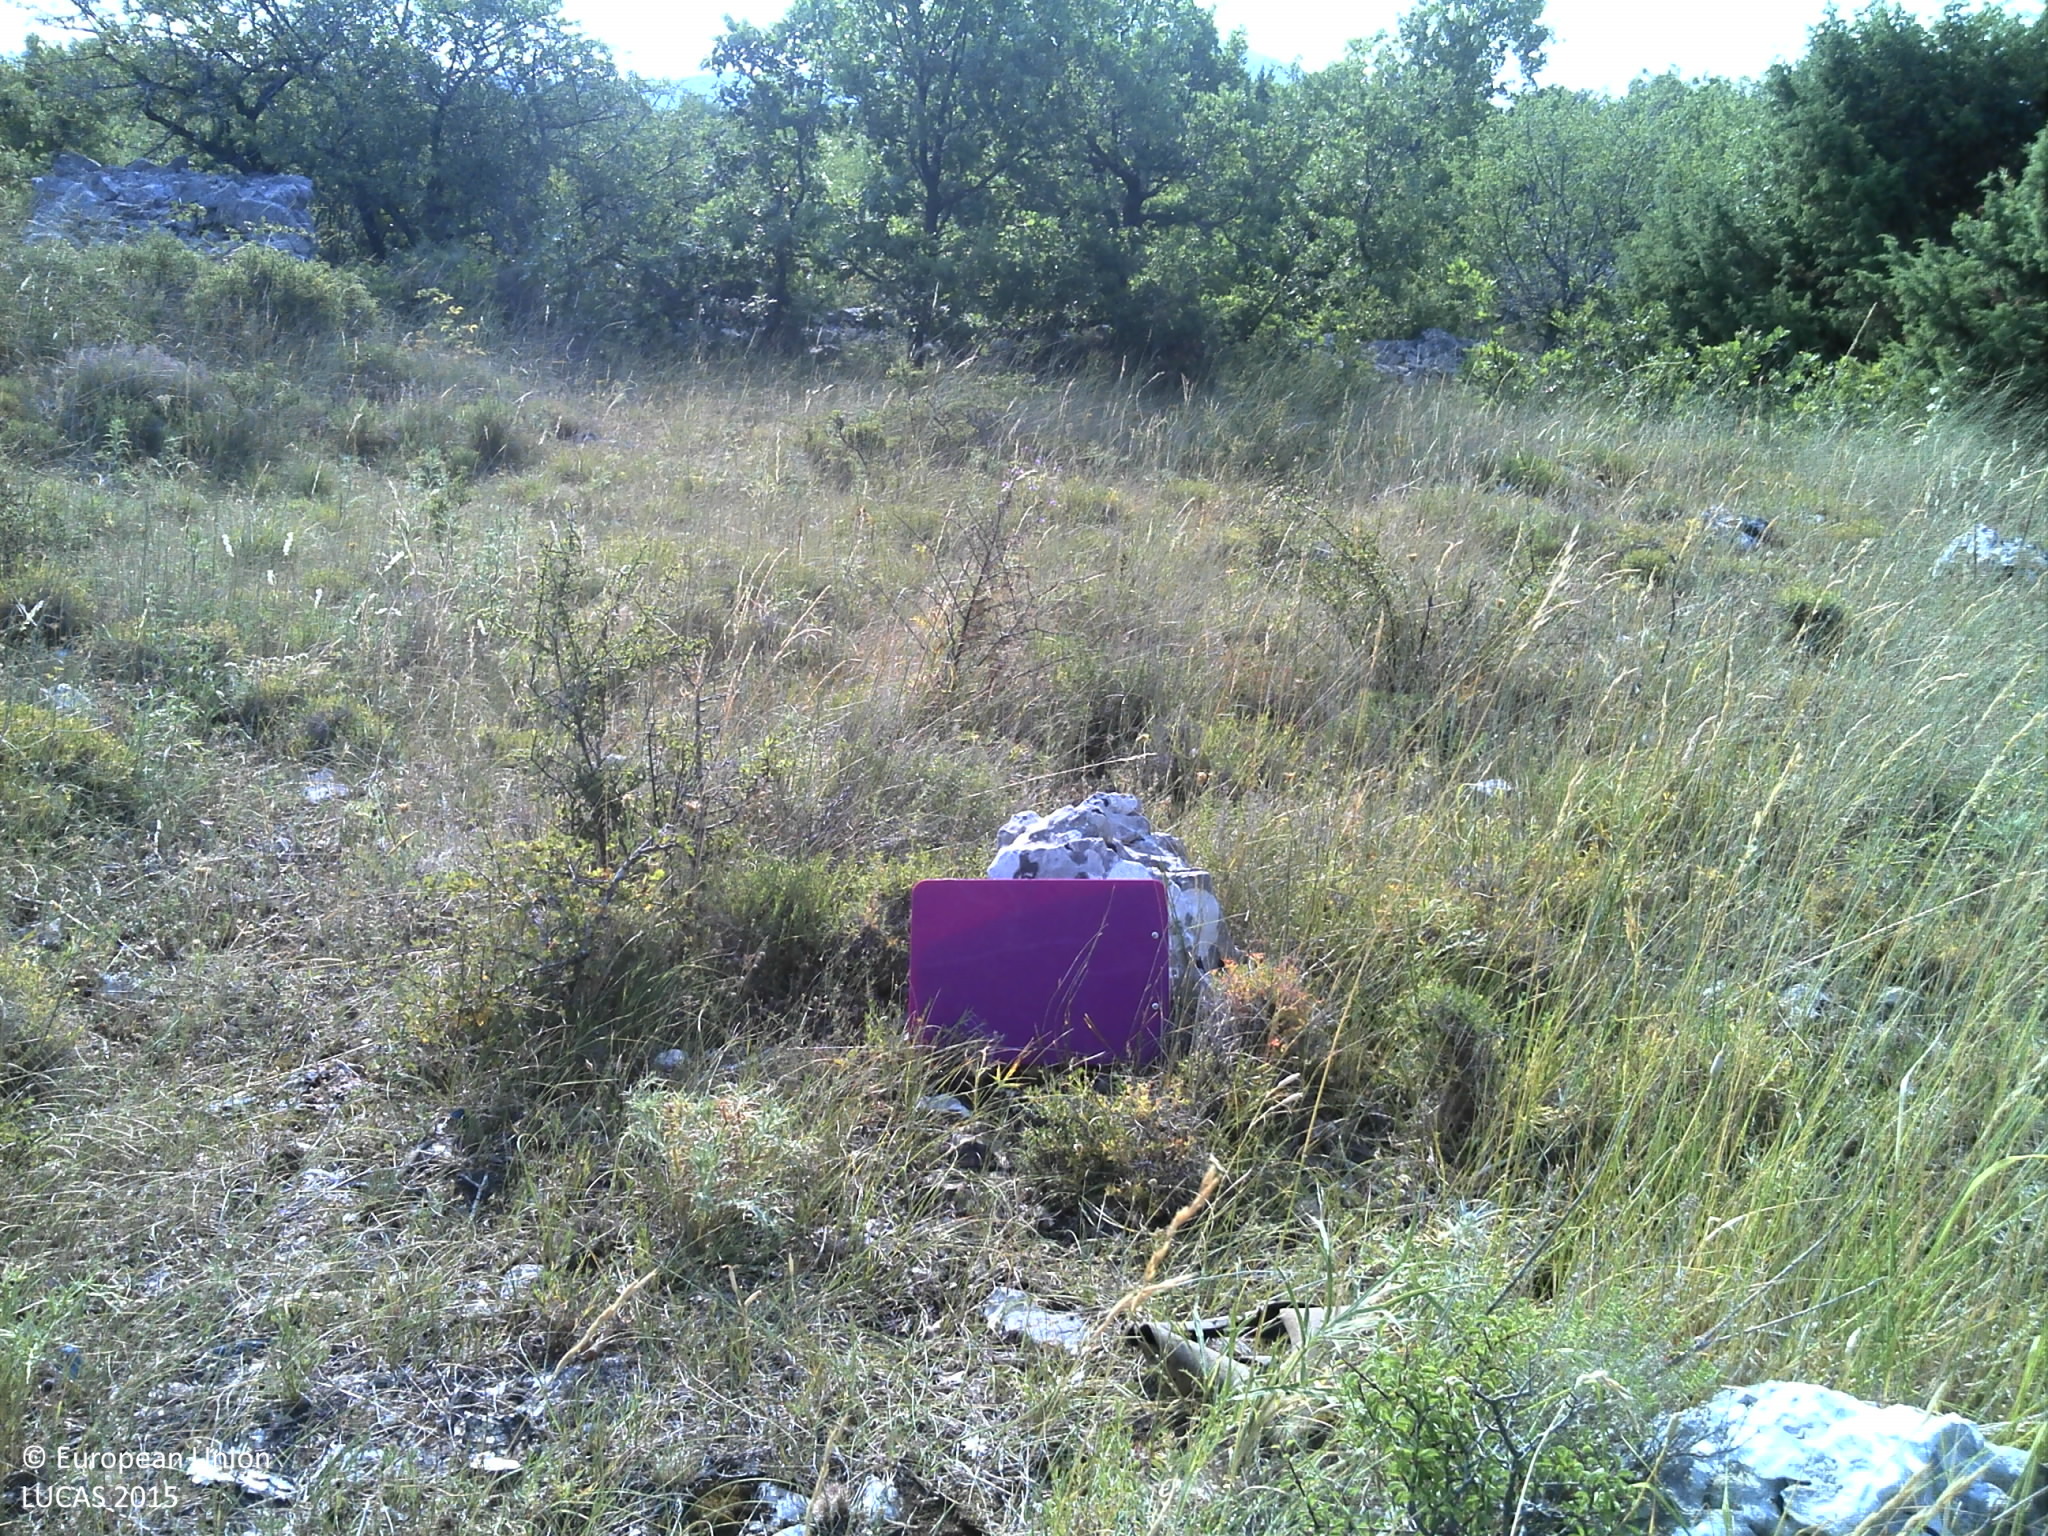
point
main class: Grassland
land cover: Grassland with sparse tree/shrub cover
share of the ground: > 75 %
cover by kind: herbaceous plants 70 %, shrubs 10 %, broadleaved forest trees 5 %, lichens and mosses 5 %, consolidated bare surface 5 %, unconsolidated bare surface 5 %
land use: Abandoned areas
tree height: > 5 m
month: July
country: HR
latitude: 43.4674
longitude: 16.9258
